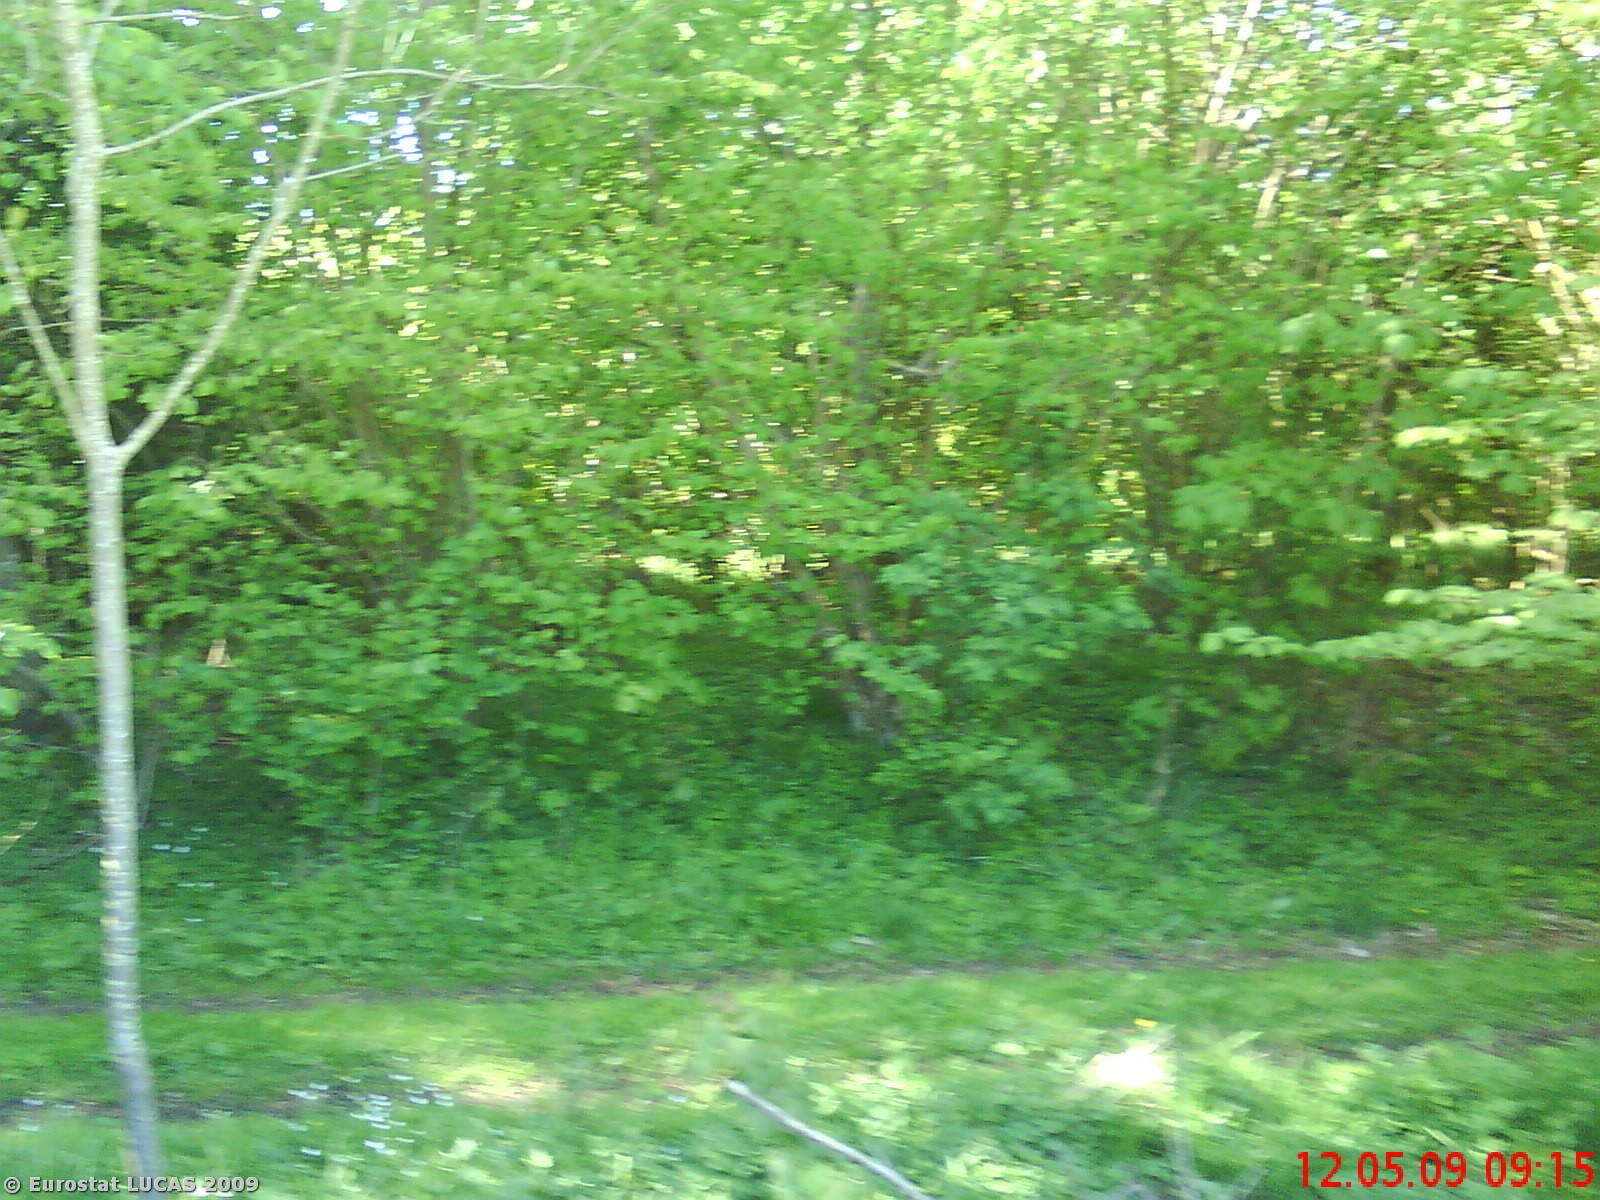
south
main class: Cropland
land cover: Rape and turnip rape
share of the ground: > 75 %
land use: Agriculture (excluding fallow land and kitchen gardens)
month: May
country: DK
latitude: 56.3291
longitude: 10.7915
